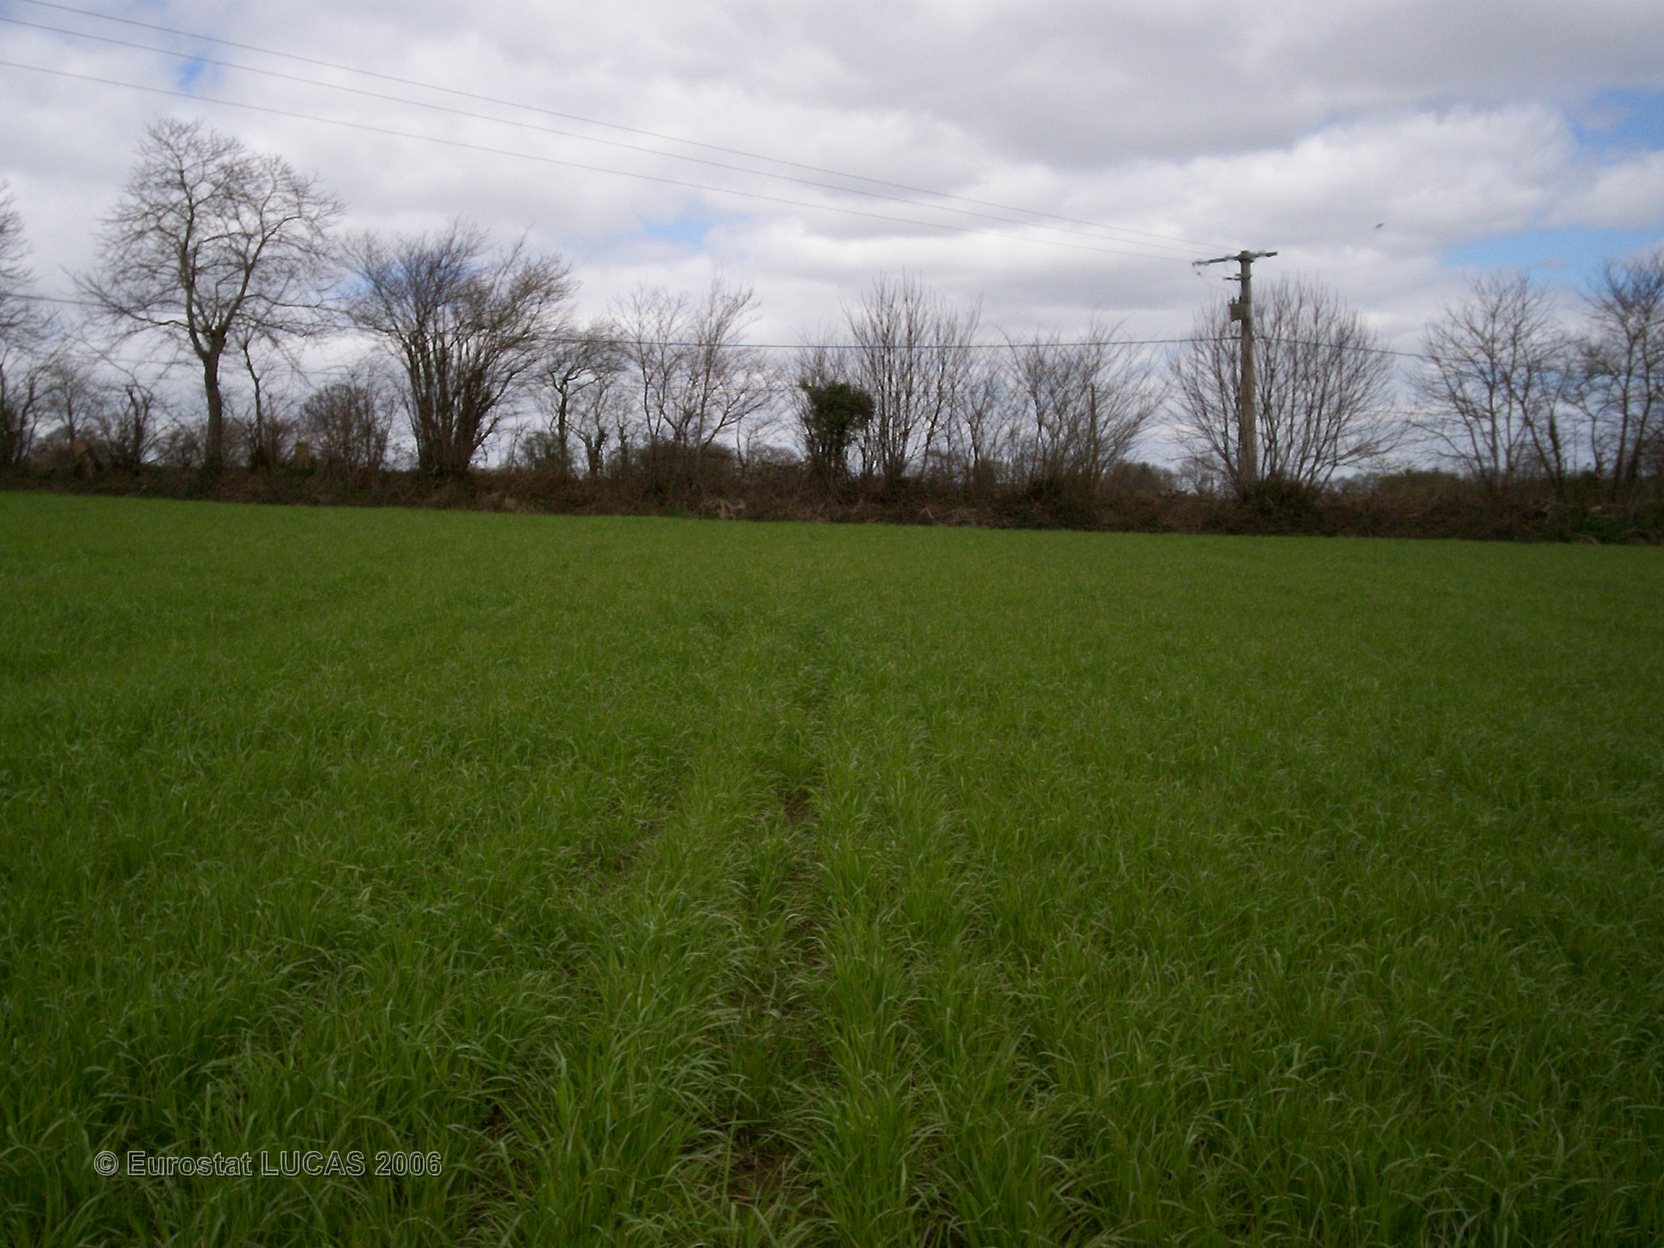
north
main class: Grassland
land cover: Grassland without tree/shrub cover
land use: Agriculture (excluding fallow land and kitchen gardens)
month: April
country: FR
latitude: 48.2145
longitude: -3.6053
